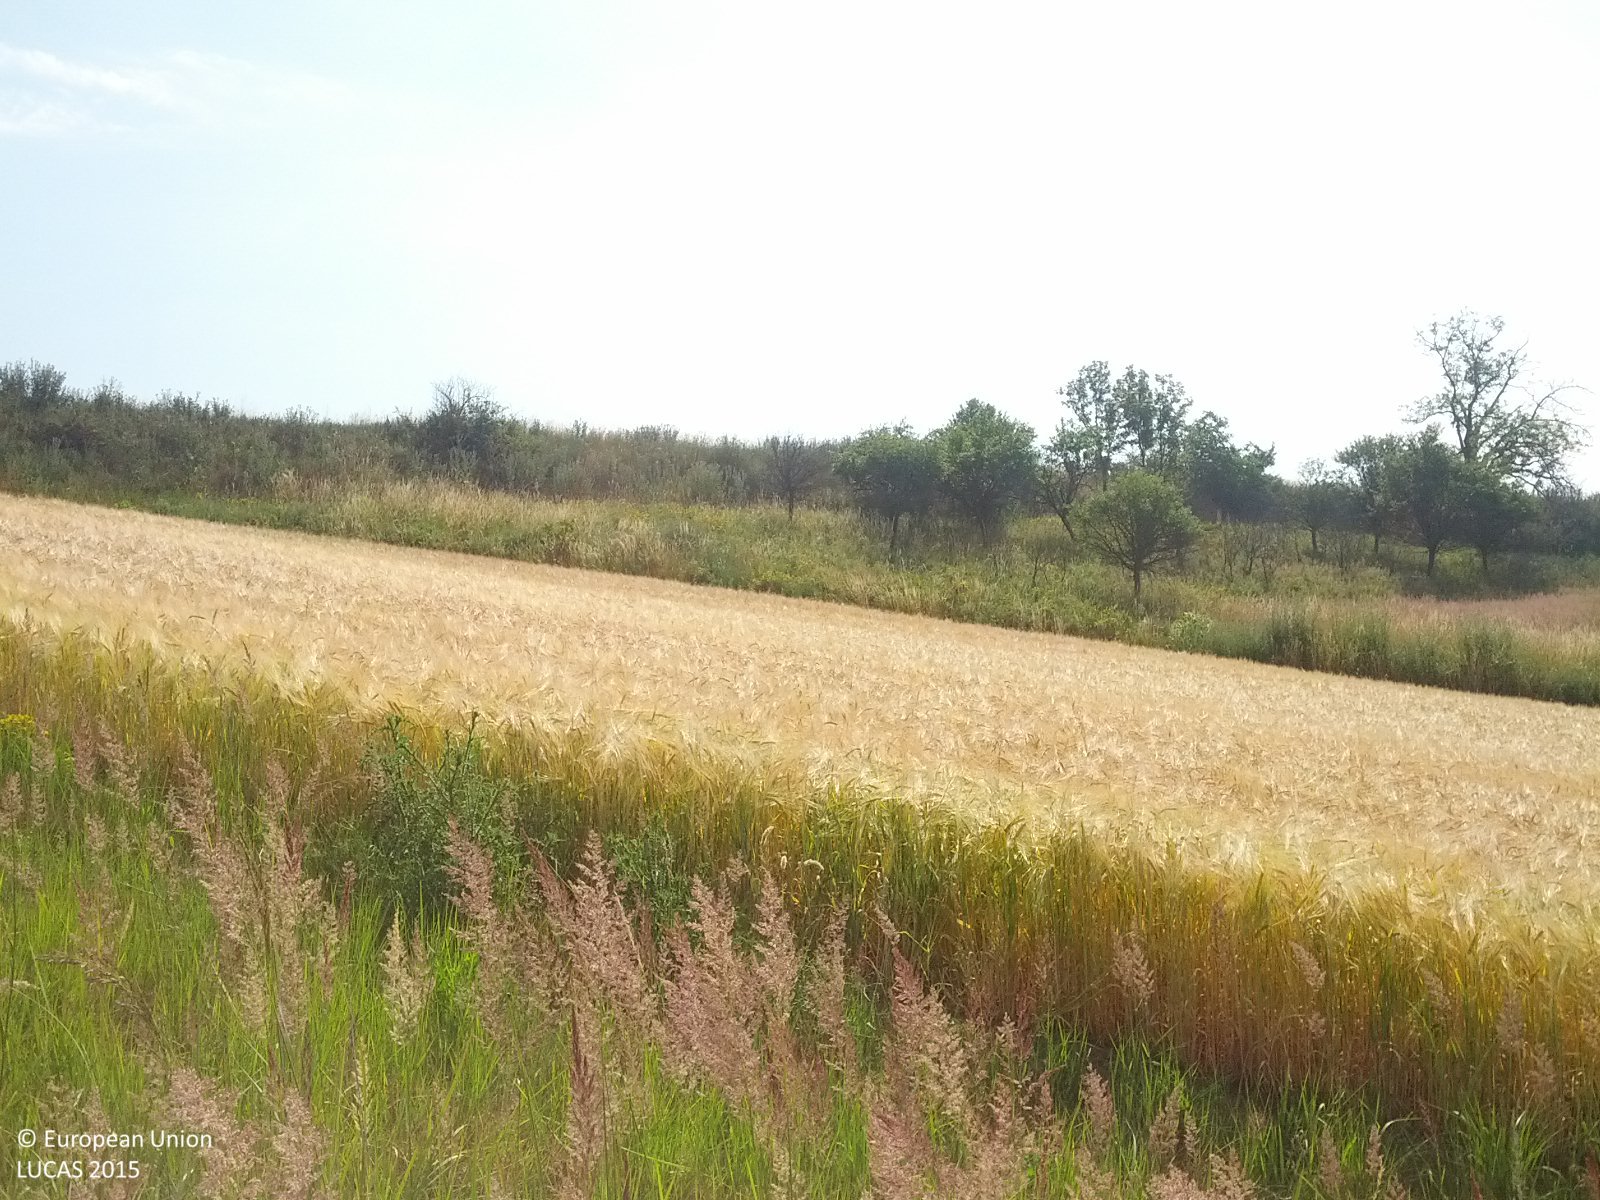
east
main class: Grassland
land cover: Grassland without tree/shrub cover
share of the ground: > 75 %
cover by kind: herbaceous plants 100 %
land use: Agriculture (excluding fallow land and kitchen gardens)
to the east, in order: Grassland without tree/shrub cover; Barley; Grassland without tree/shrub cover; Tracks; Grassland without tree/shrub cover; Common wheat; Barley; Grassland without tree/shrub cover
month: July
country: AT
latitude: 48.6695
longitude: 16.7016
